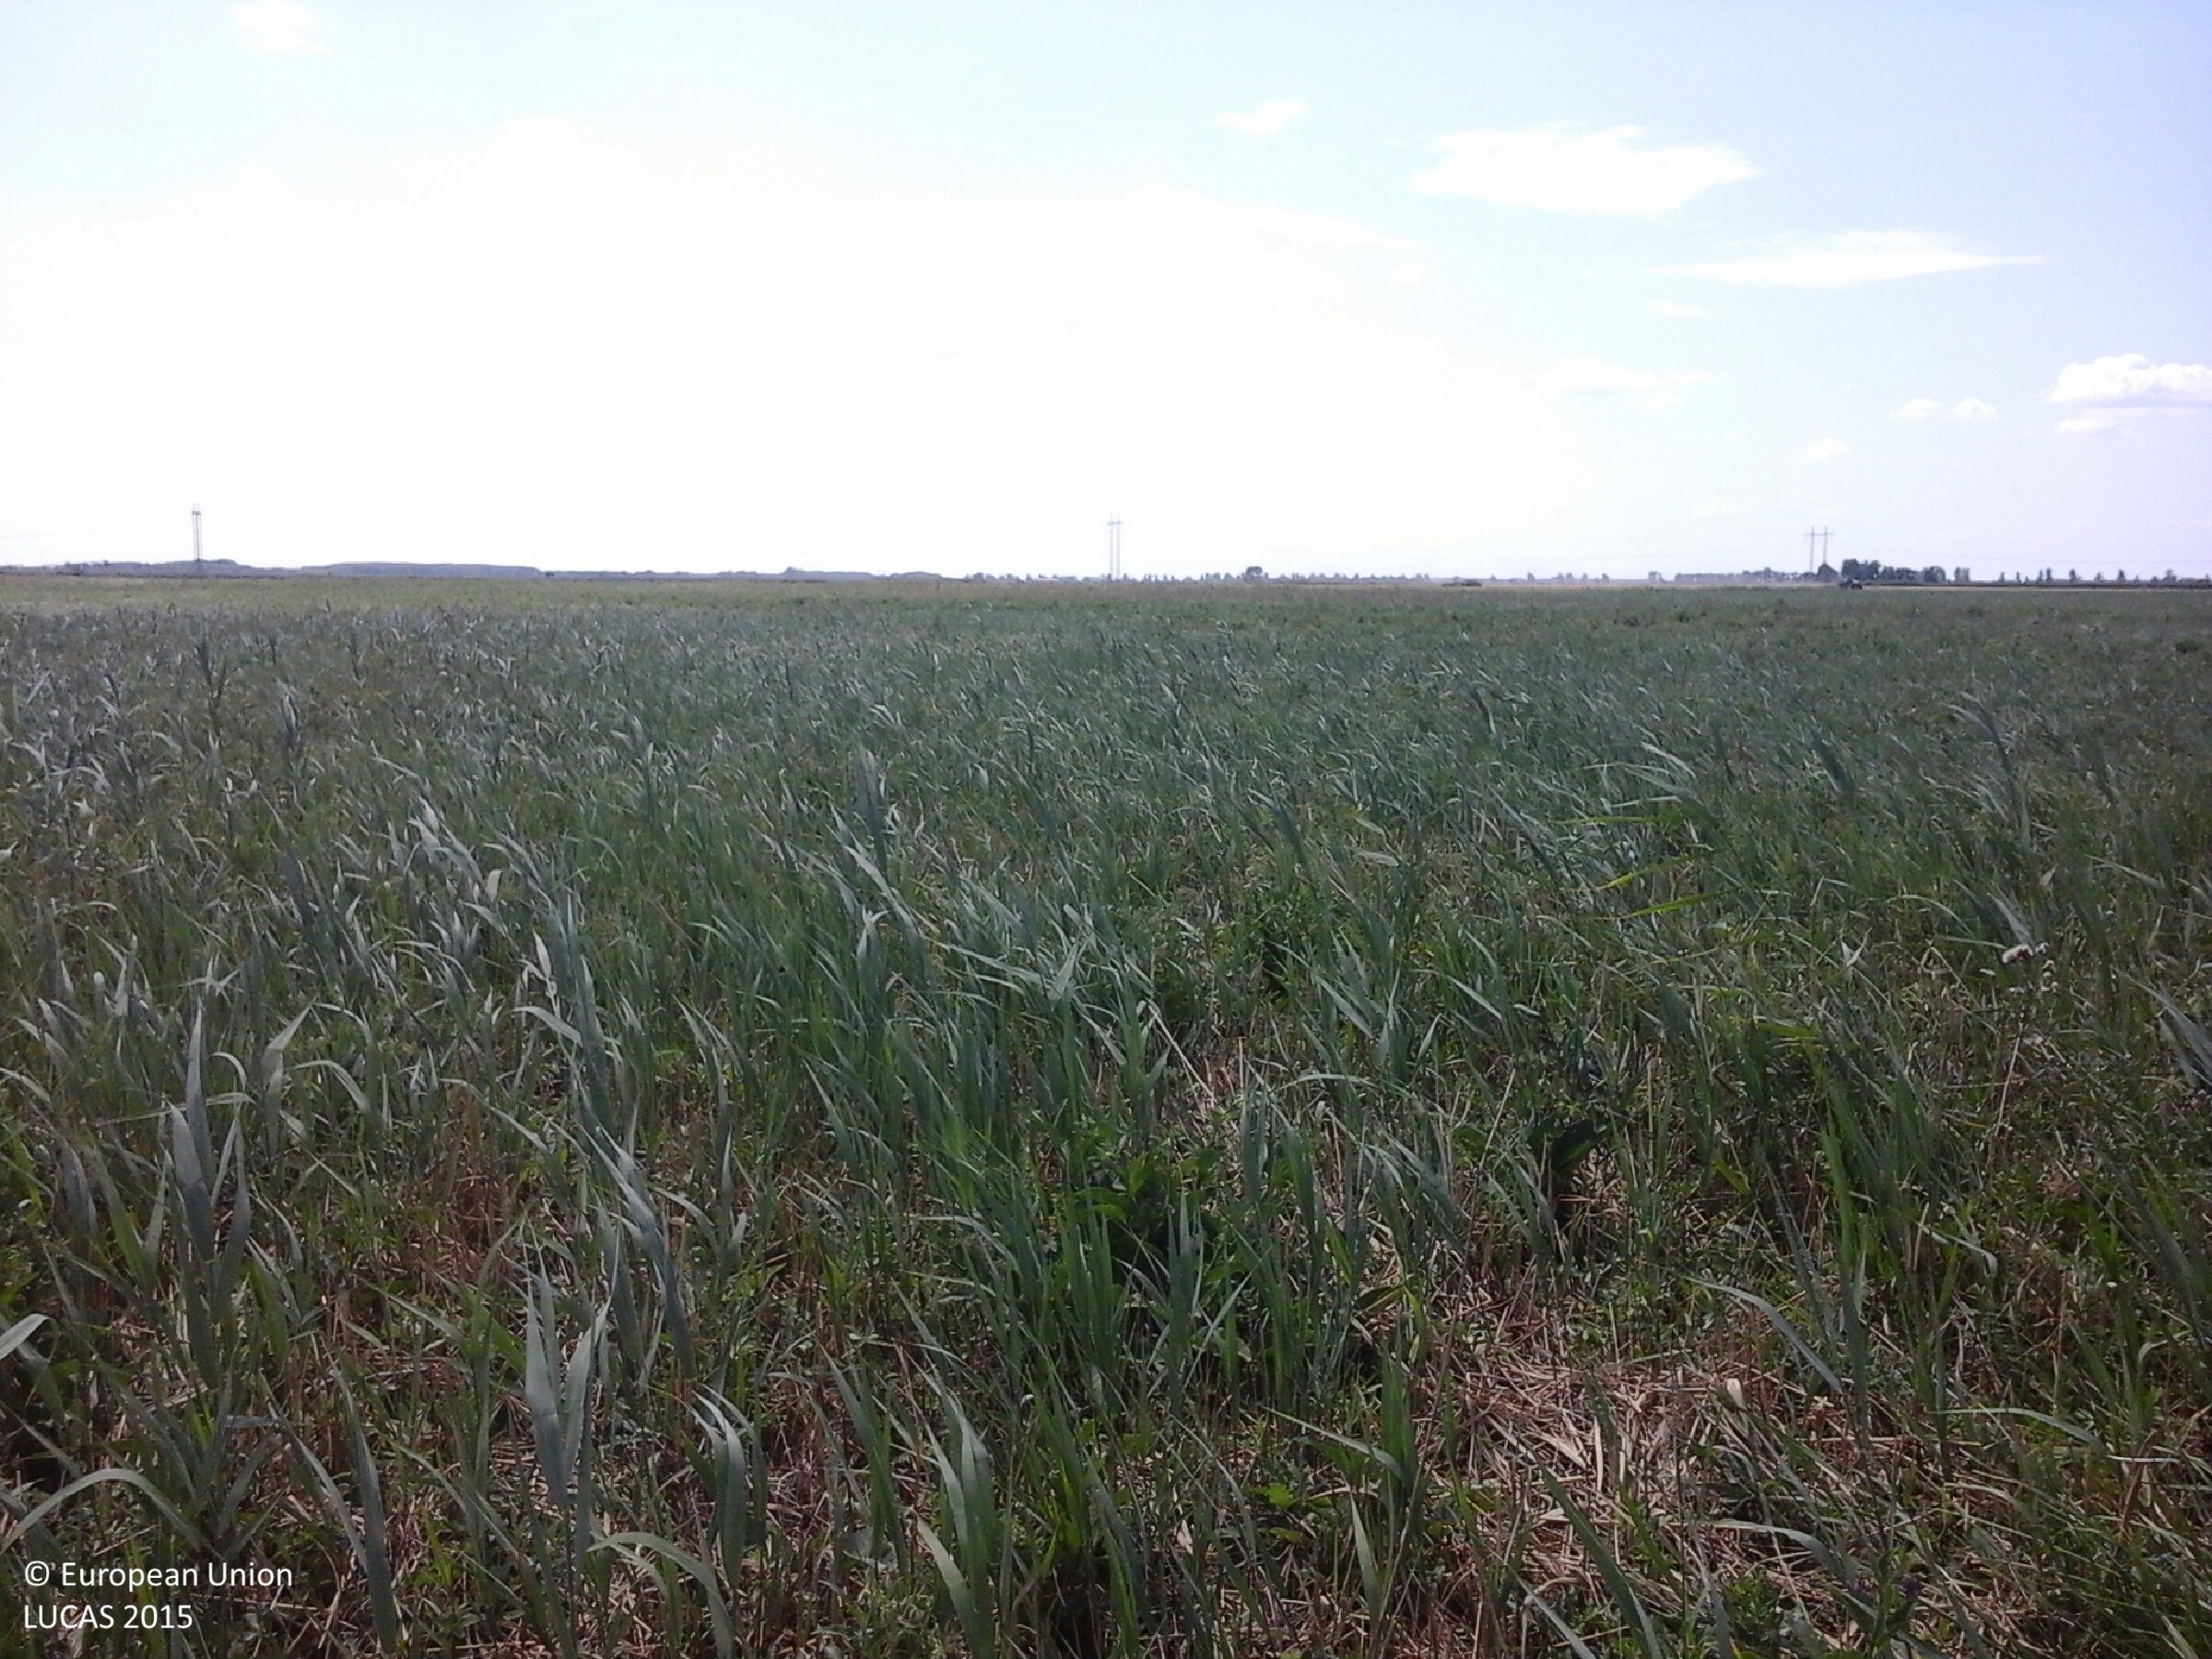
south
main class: Cropland
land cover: Permanent industrial crops
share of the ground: > 75 %
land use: Agriculture (excluding fallow land and kitchen gardens)
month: July
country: HU
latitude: 47.7819
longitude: 20.6174
